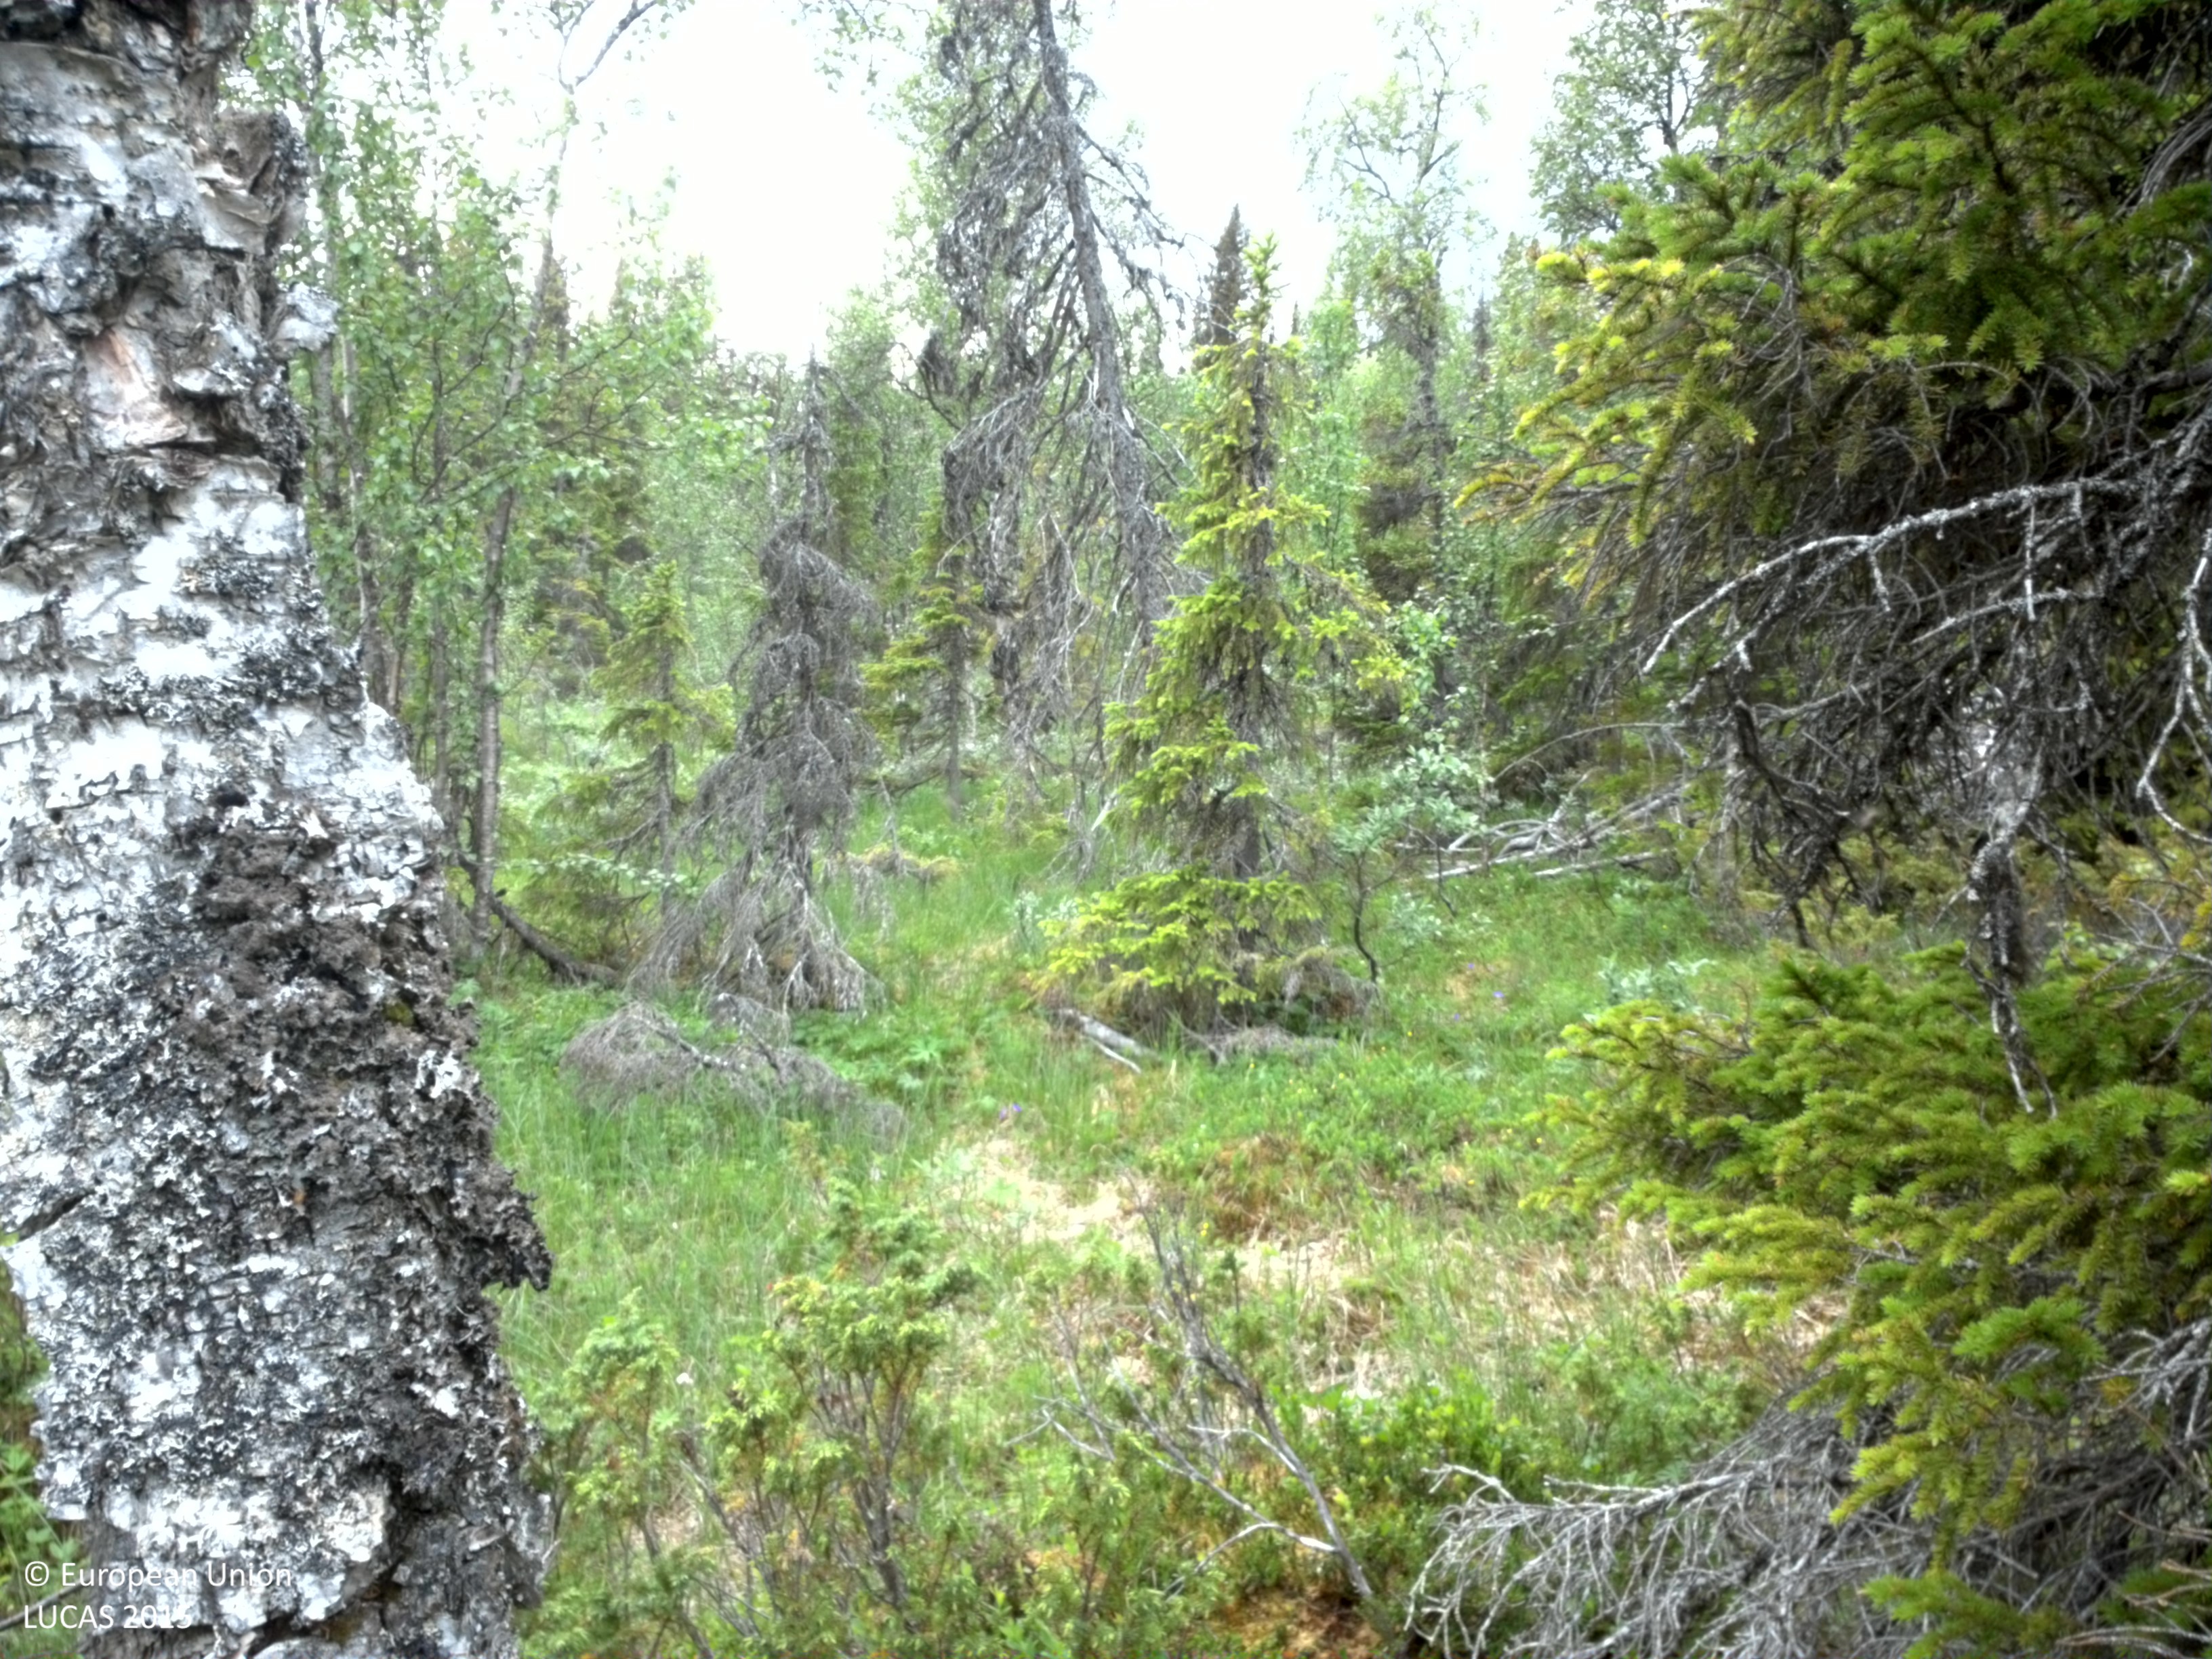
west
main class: Woodland
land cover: Spruce dominated mixed woodland
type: boreal forest
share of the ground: 25 - 50 %
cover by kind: herbaceous plants 35 %, shrubs 30 %, coniferous forest trees 15 %, broadleaved forest trees 10 %, lichens and mosses 10 %
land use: Semi-natural and natural areas not in use
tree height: > 5 m
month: July
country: SE
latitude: 65.6748
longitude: 15.6416
